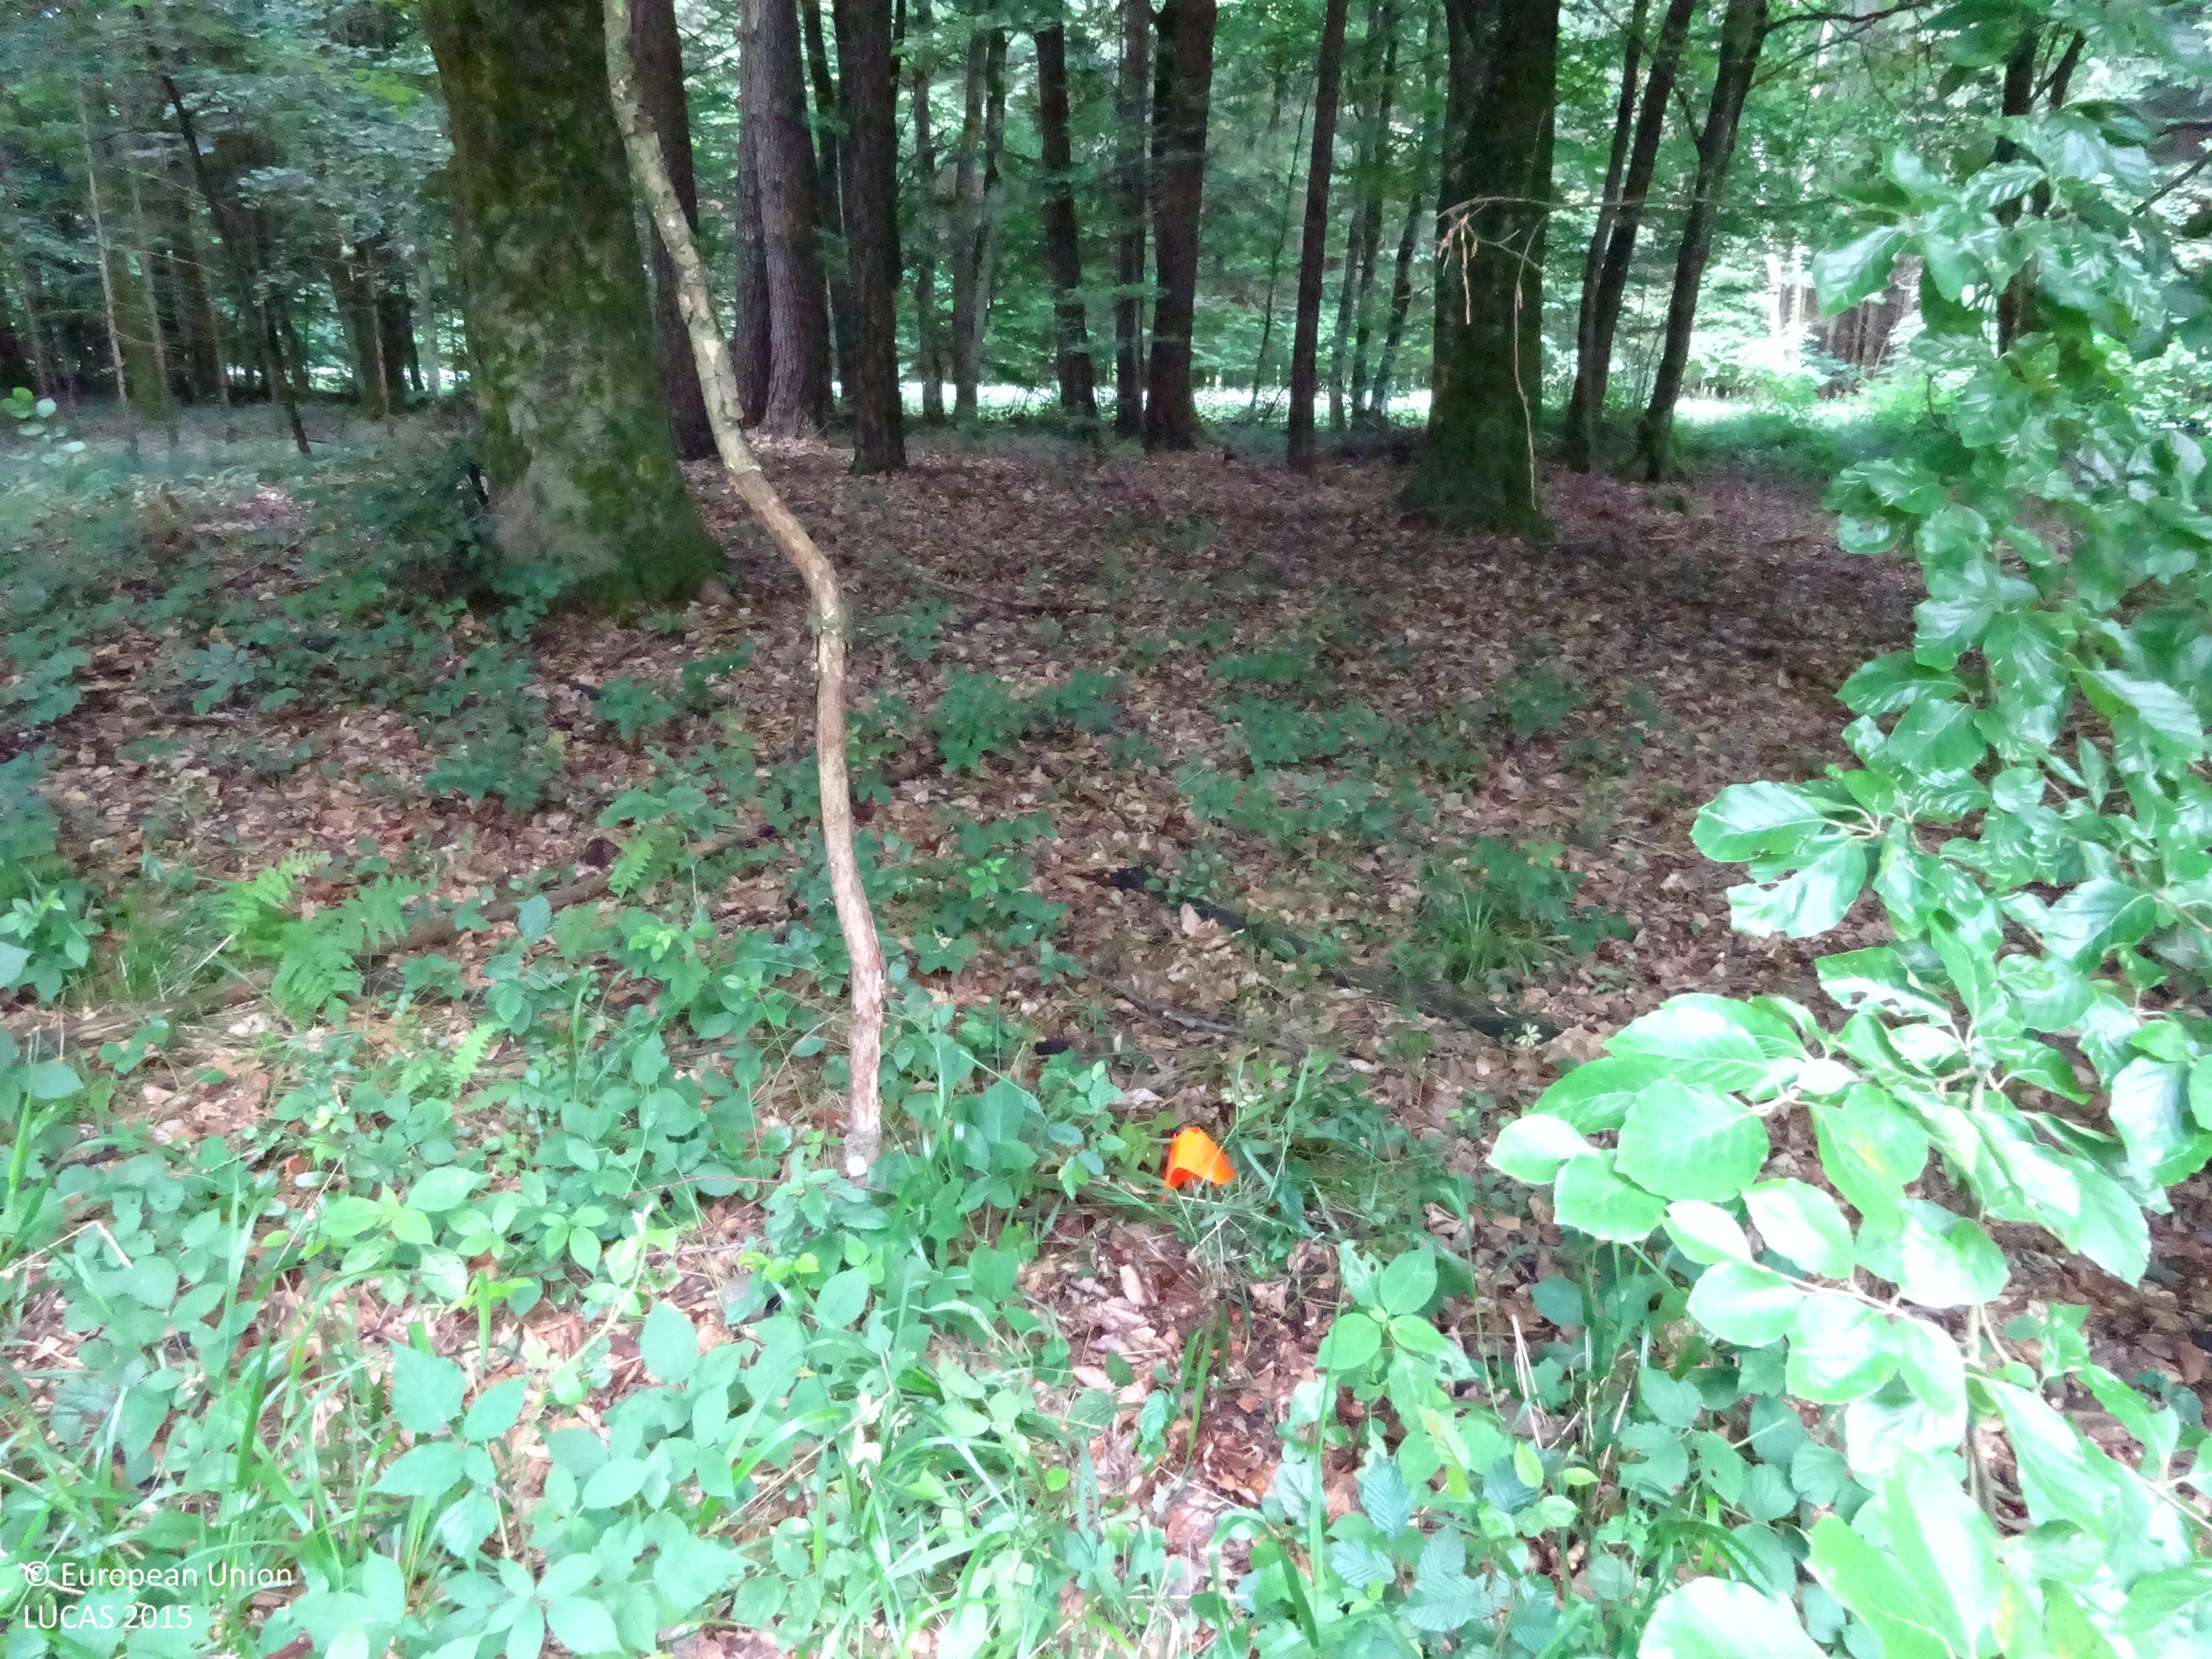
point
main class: Woodland
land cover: Broadleaved woodland
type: mountainous beech forest
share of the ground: > 75 %
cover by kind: broadleaved forest trees 80 %, coniferous forest trees 20 %
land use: Forestry
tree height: > 5 m
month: June
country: AT
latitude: 46.7450
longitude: 15.9558
